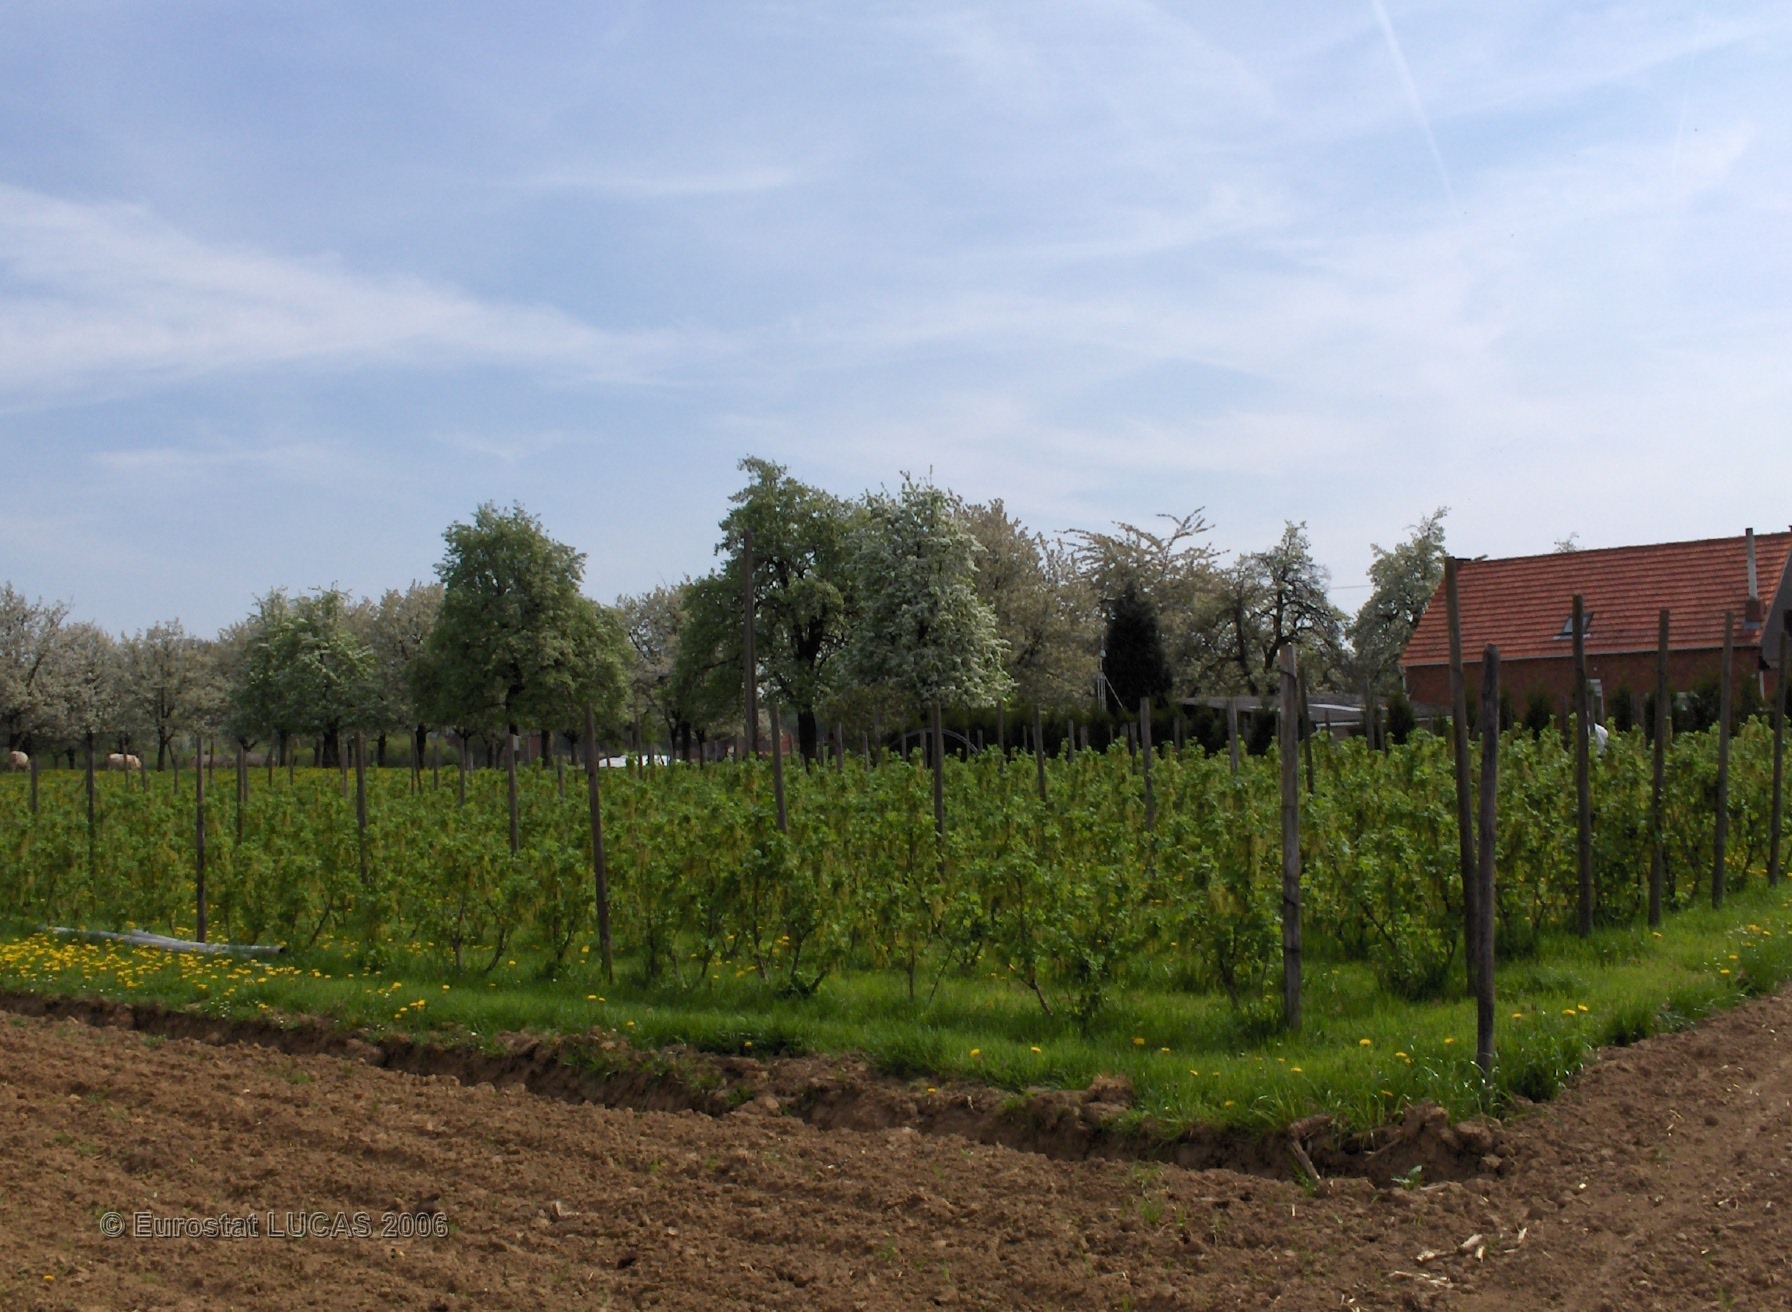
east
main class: Cropland
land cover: Maize
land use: Agriculture (excluding fallow land and kitchen gardens)
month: May
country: BE
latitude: 50.7326
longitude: 5.2229
